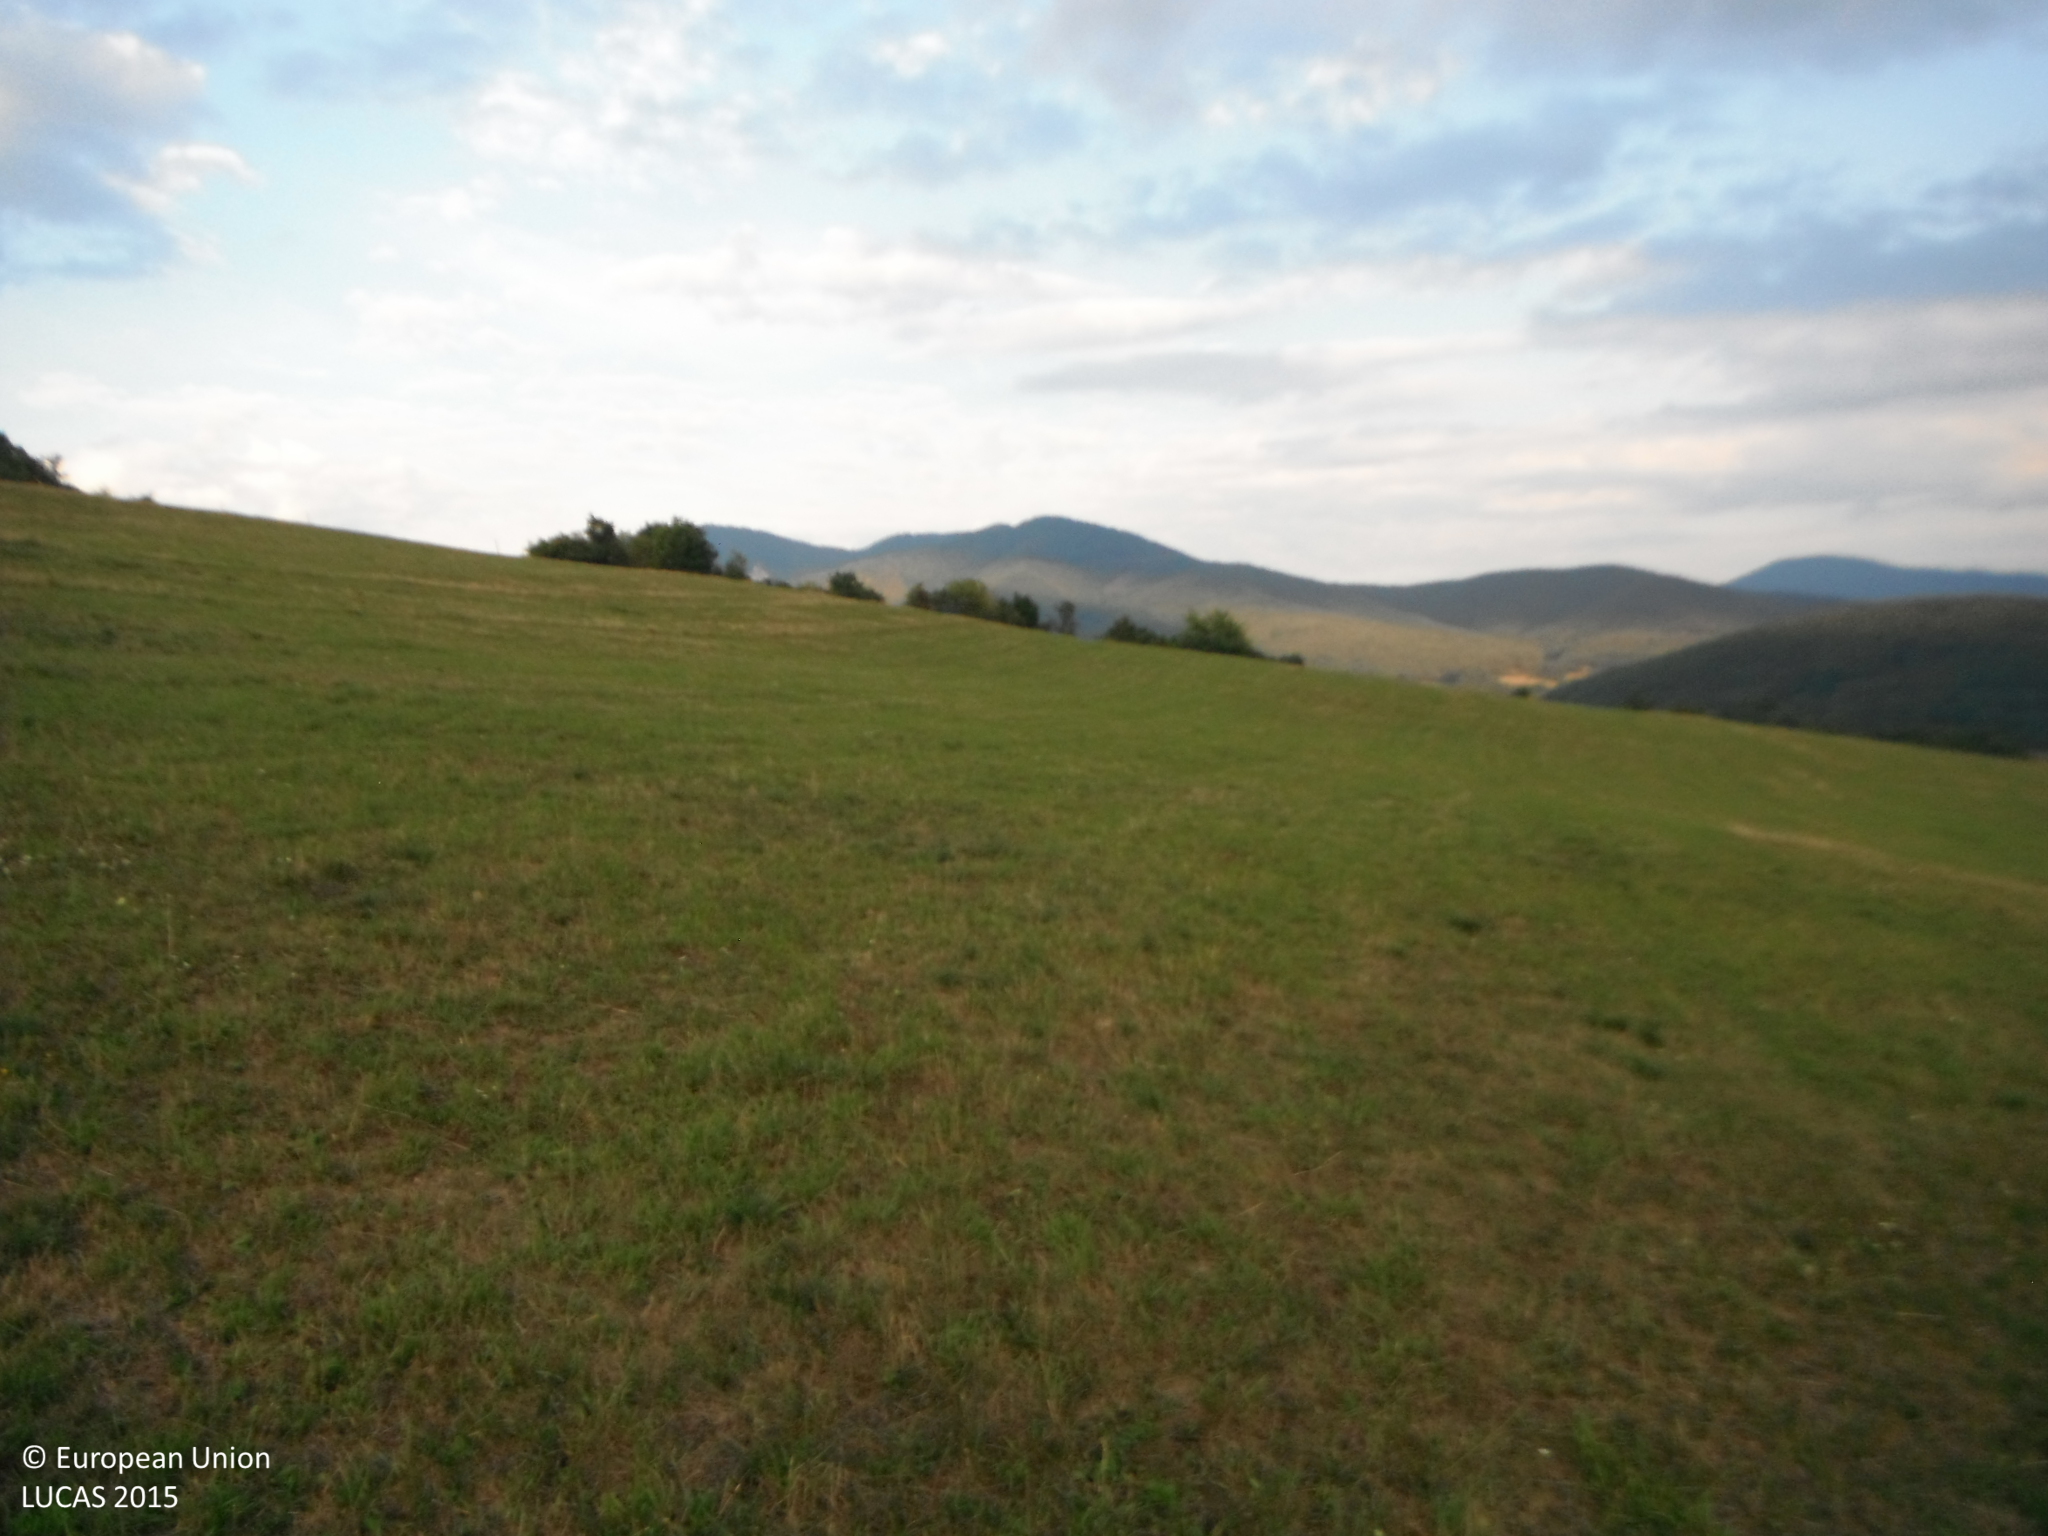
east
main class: Grassland
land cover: Grassland without tree/shrub cover
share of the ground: > 75 %
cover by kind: herbaceous plants 100 %
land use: Agriculture (excluding fallow land and kitchen gardens)
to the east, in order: Grassland without tree/shrub cover; Tracks; Shrubland with sparse tree cover; Grass margins; Fences; Rape and turnip rape
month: August
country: SK
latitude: 48.8117
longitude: 18.3366
